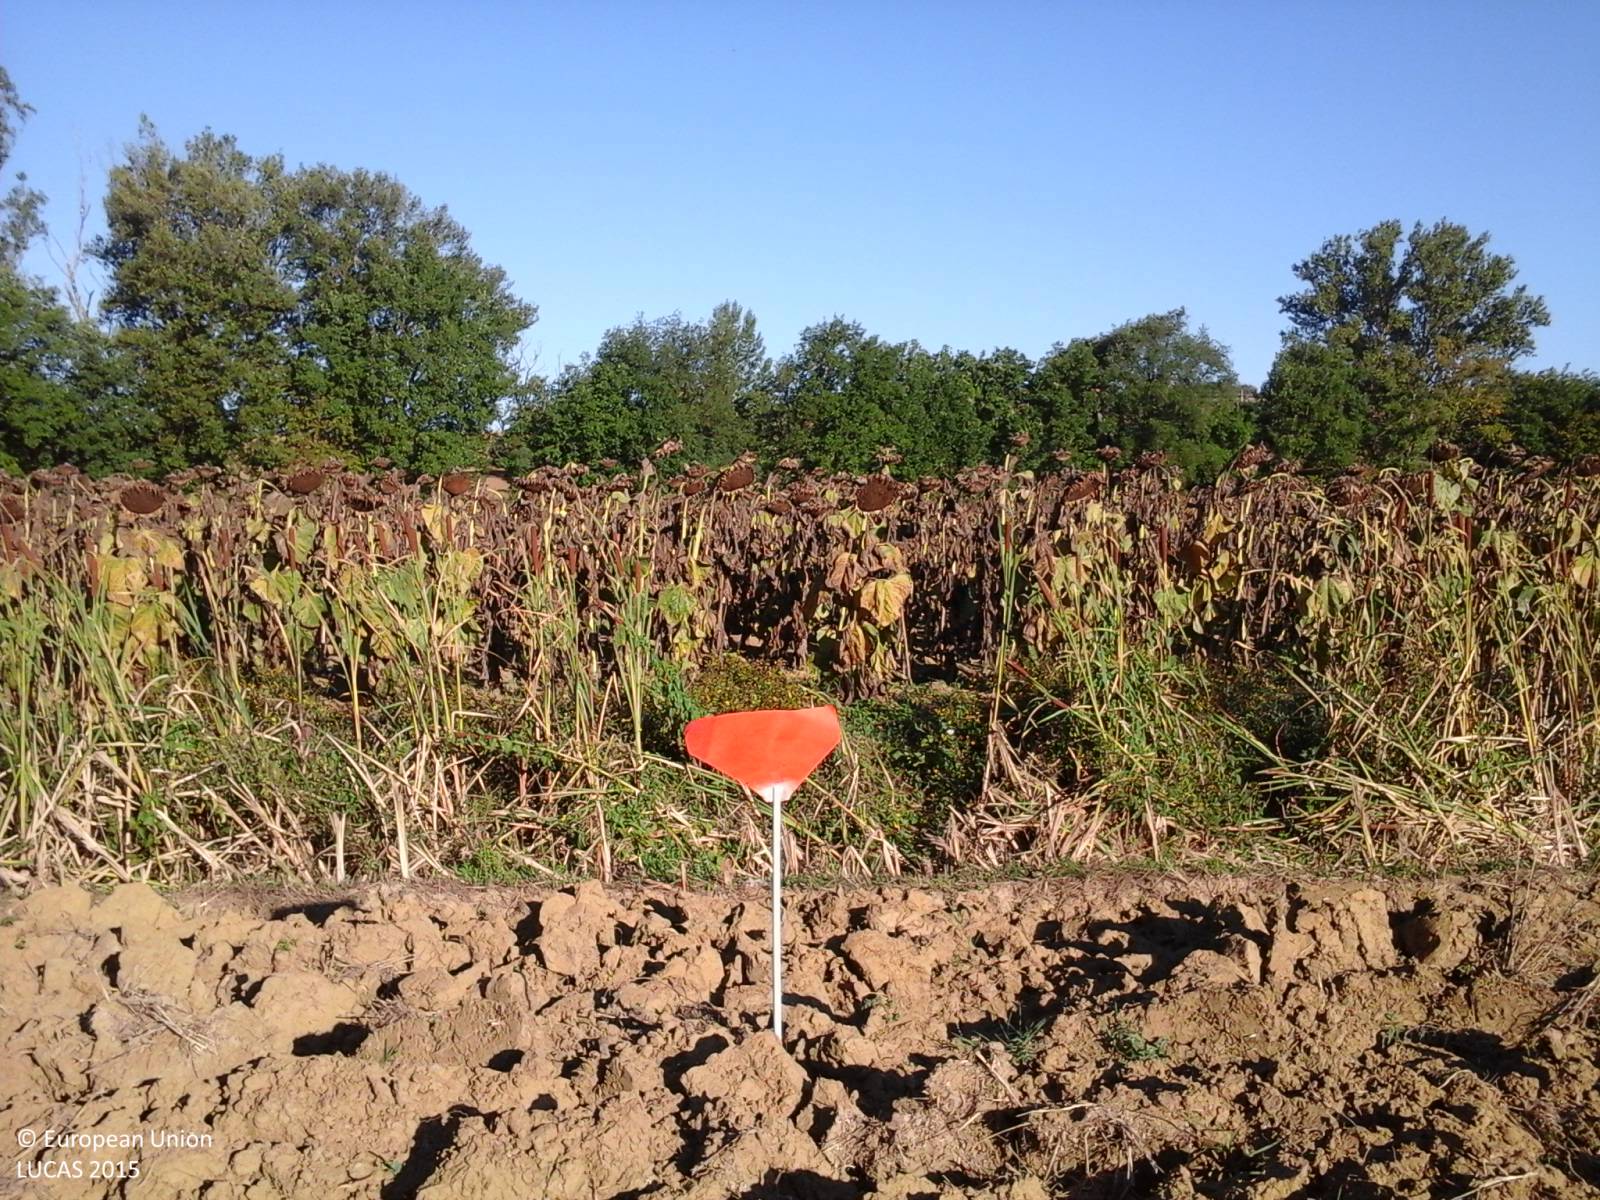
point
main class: Cropland
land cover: Common wheat
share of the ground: < 10 %
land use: Agriculture (excluding fallow land and kitchen gardens)
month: September
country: IT
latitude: 43.0600
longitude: 12.3628
